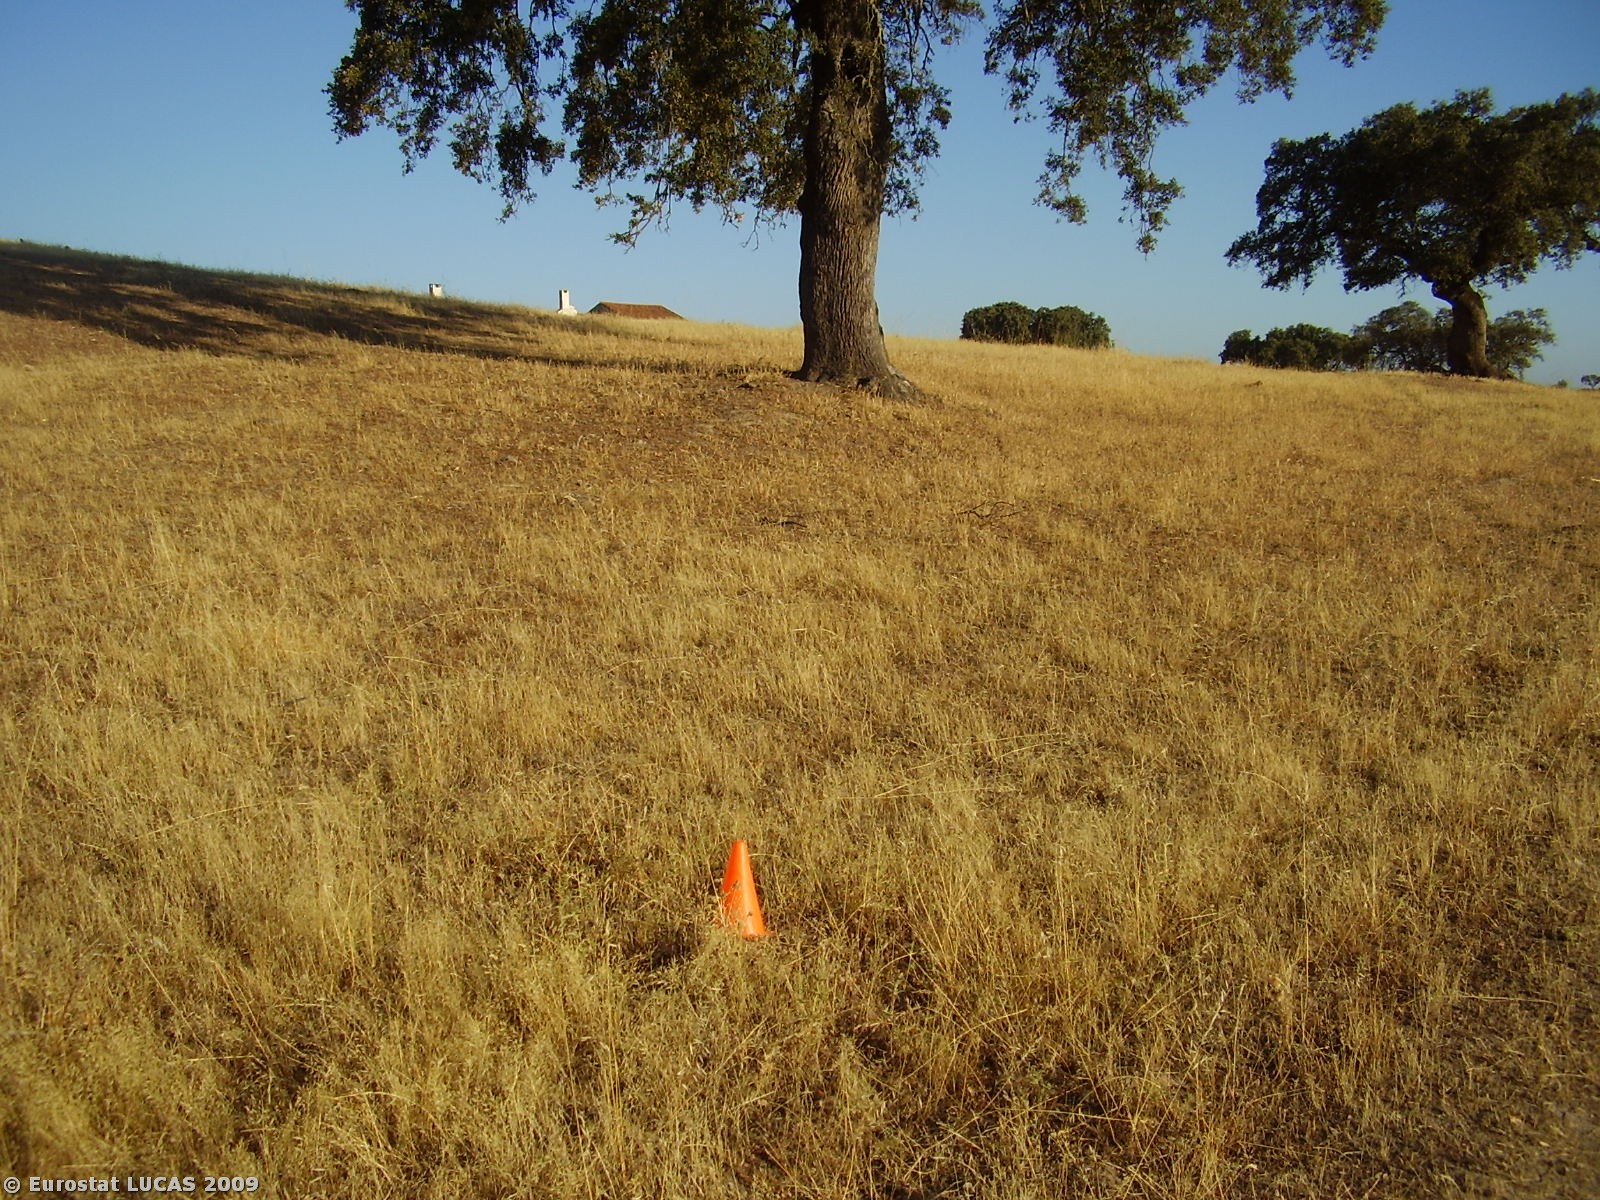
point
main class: Grassland
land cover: Grassland with sparse tree/shrub cover
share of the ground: > 75 %
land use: Agriculture (excluding fallow land and kitchen gardens)
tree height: > 5 m
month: July
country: PT
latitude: 38.6443
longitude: -7.2951
